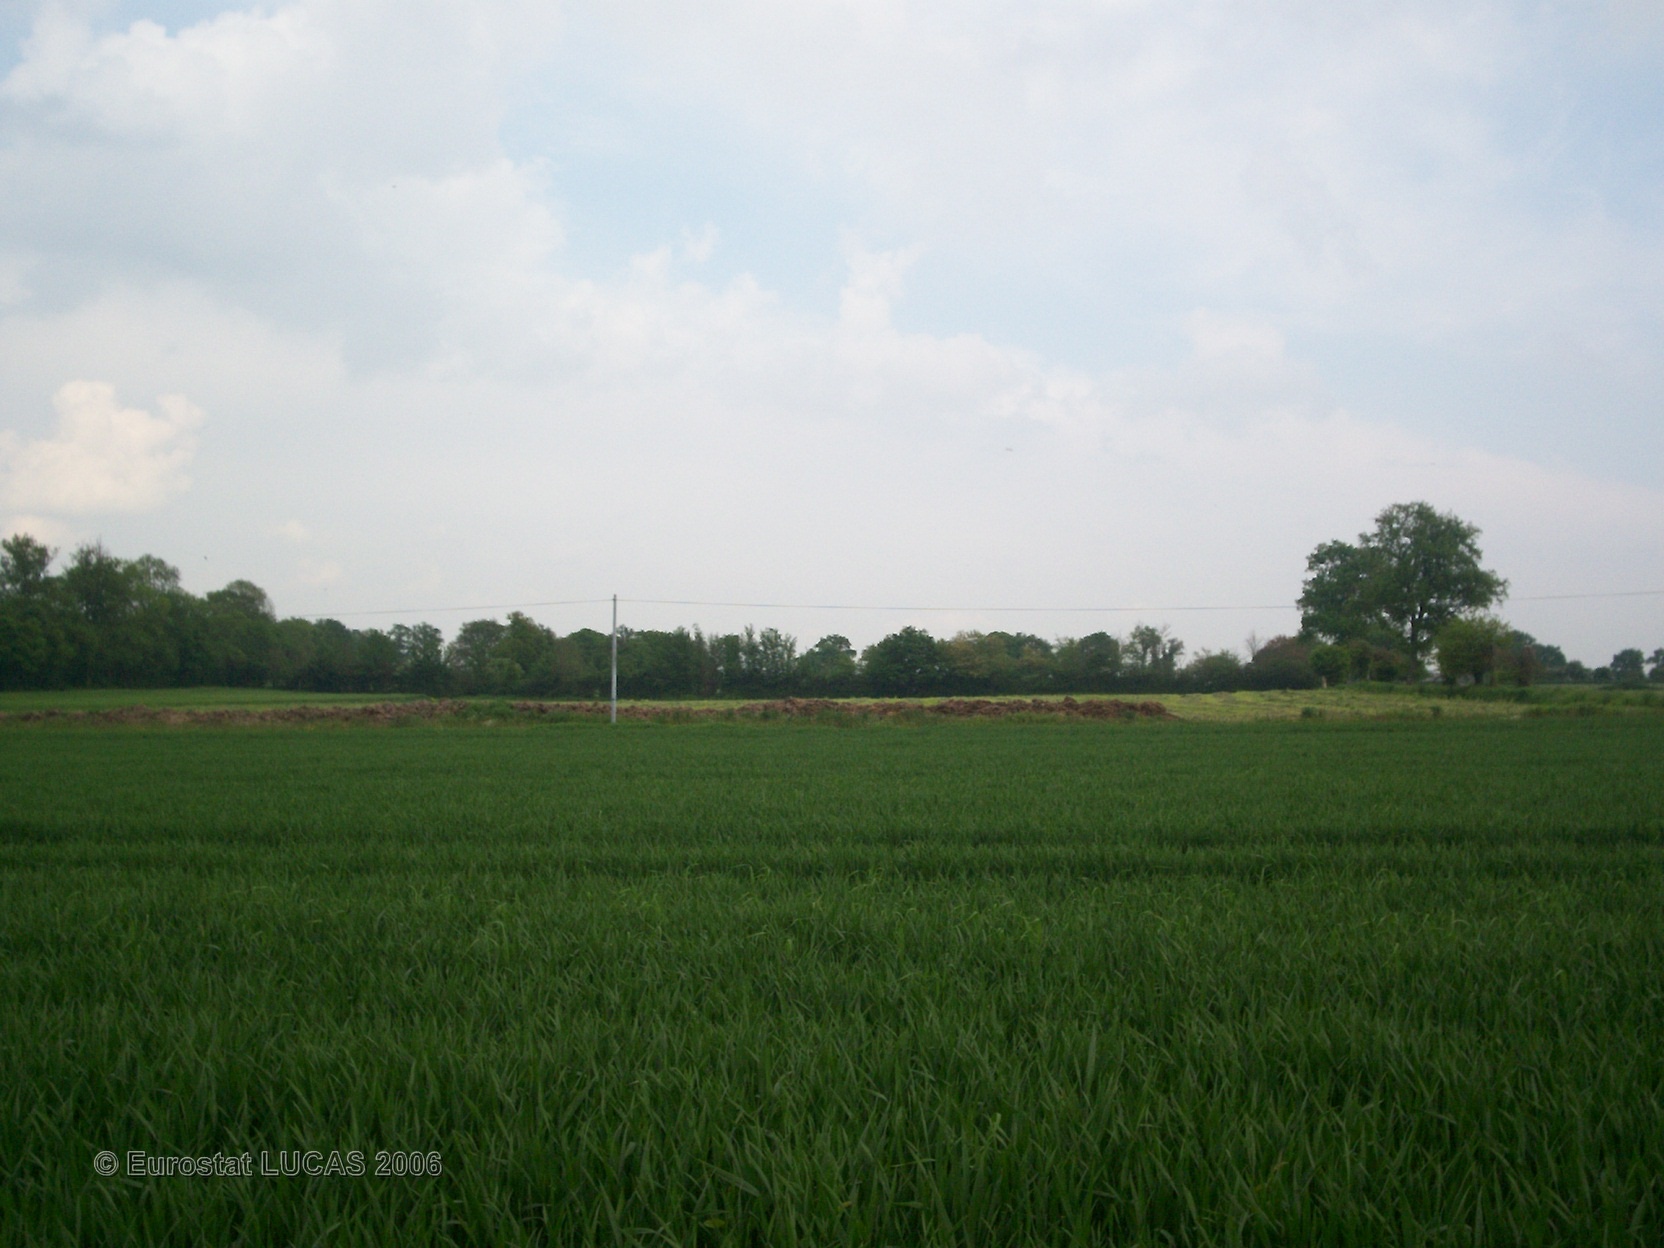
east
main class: Cropland
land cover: Common wheat
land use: Agriculture (excluding fallow land and kitchen gardens)
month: May
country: FR
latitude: 47.8404
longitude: -0.5756
